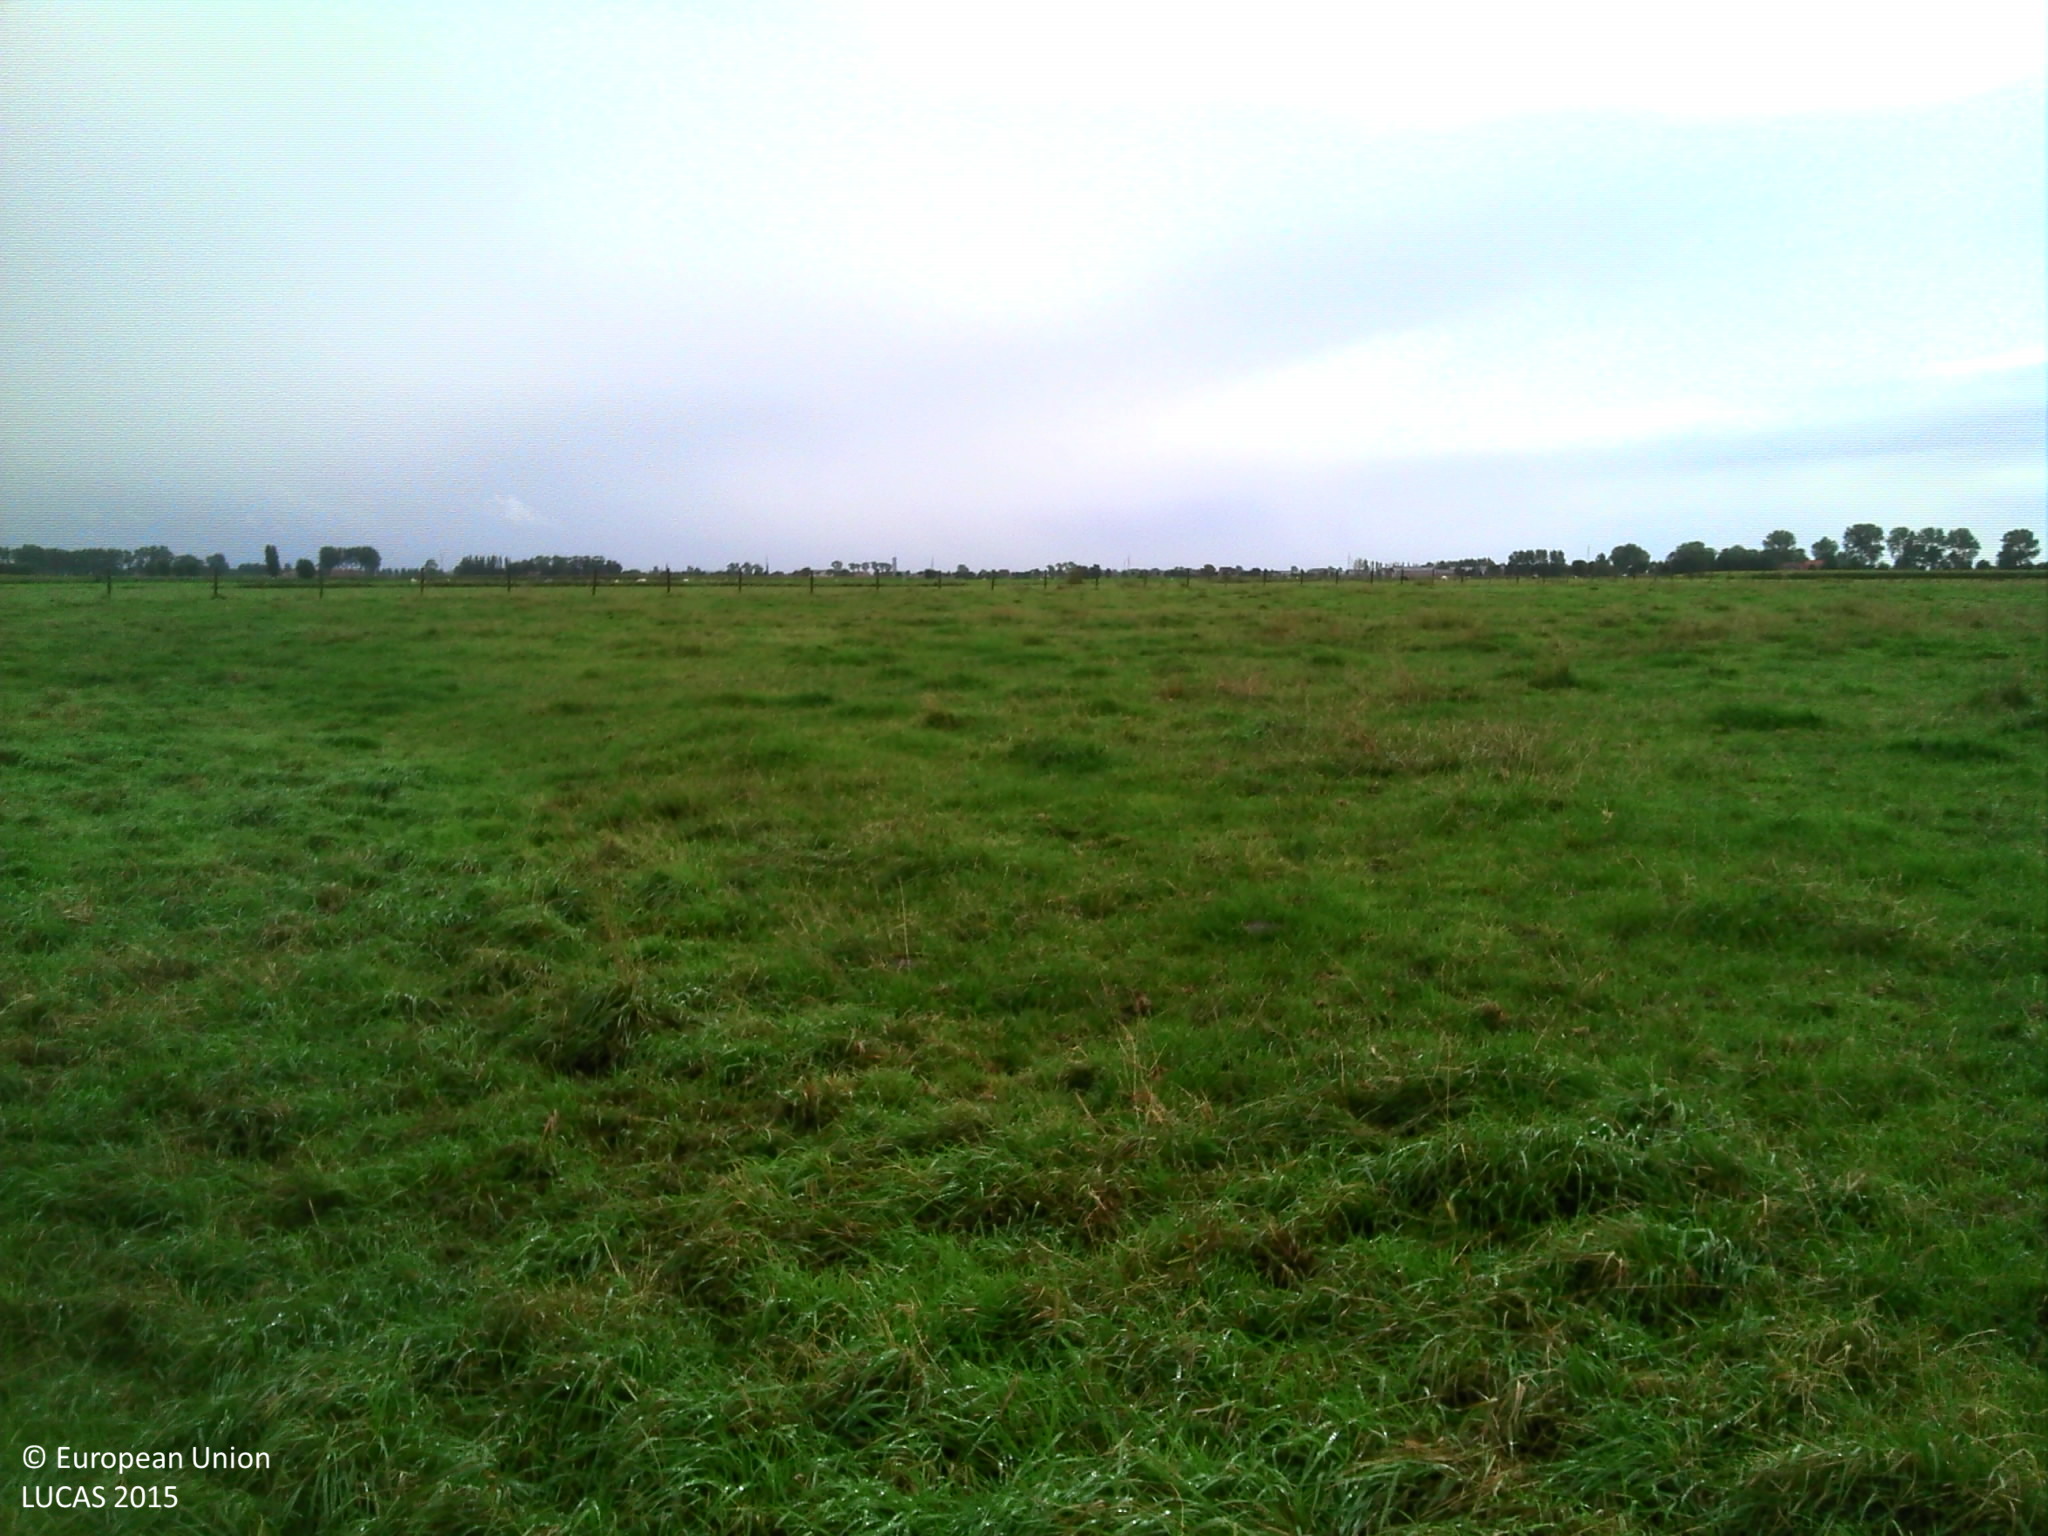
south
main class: Grassland
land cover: Grassland without tree/shrub cover
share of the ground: > 75 %
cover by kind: herbaceous plants 100 %
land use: Agriculture (excluding fallow land and kitchen gardens)
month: September
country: BE
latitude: 51.0978
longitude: 2.8636
